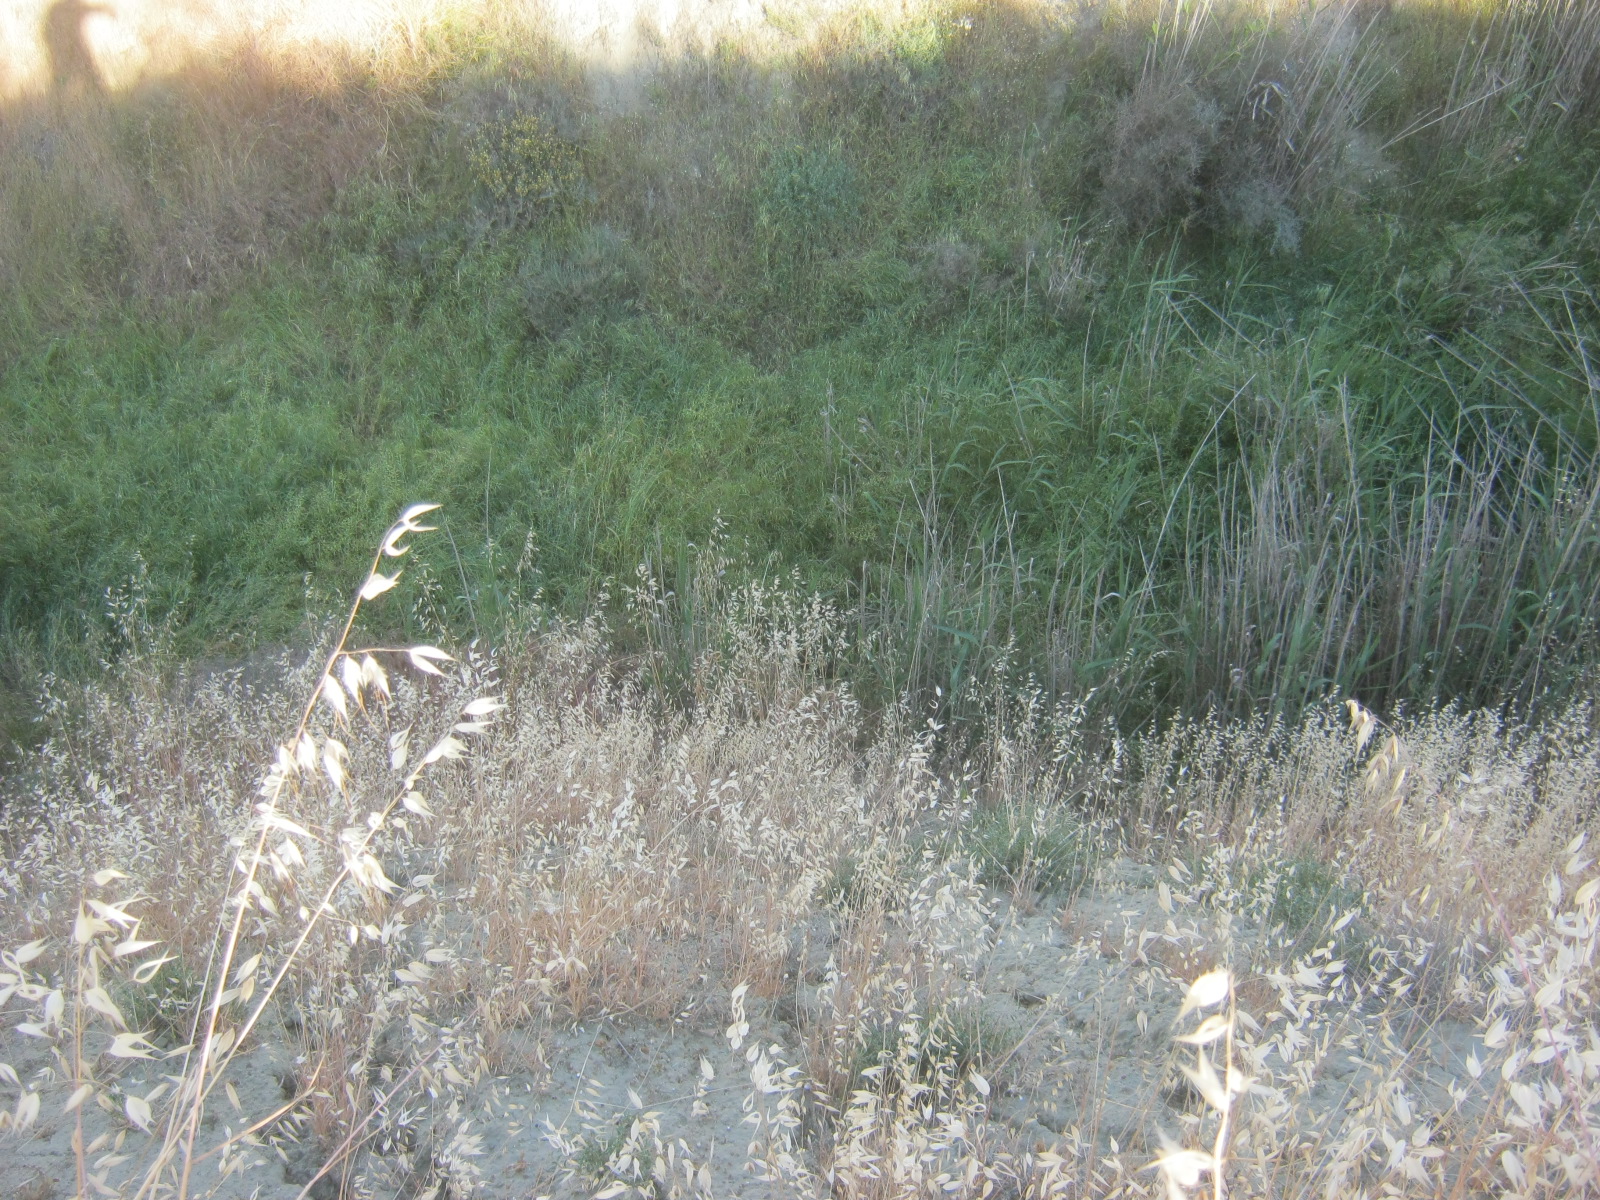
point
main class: Grassland
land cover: Spontaneously vegetated surfaces
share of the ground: > 75 %
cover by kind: herbaceous plants 95 %, unconsolidated bare surface 5 %
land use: Semi-natural and natural areas not in use
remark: Temporary dry
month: May
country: CY
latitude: 35.0563
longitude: 33.2204
